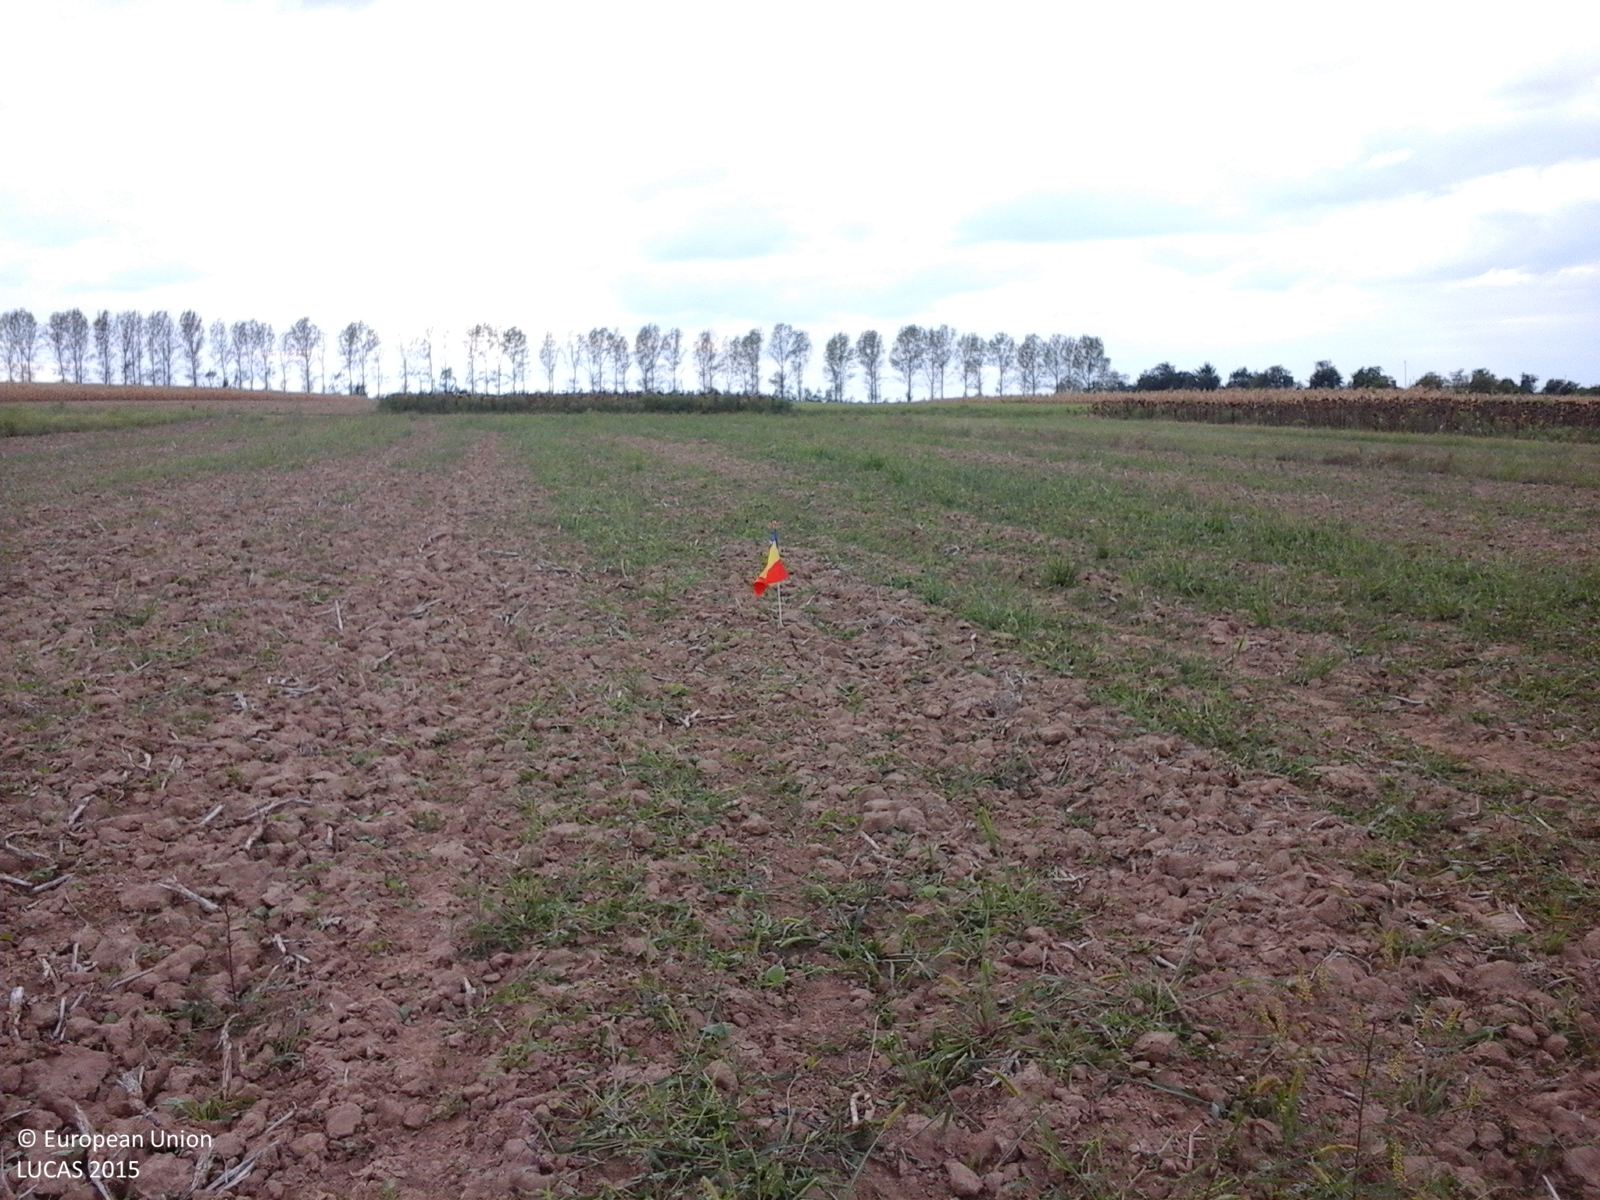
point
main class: Cropland
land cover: Rape and turnip rape
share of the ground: 10 - 25 %
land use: Agriculture (excluding fallow land and kitchen gardens)
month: September
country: RO
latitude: 47.4938
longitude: 22.6291
